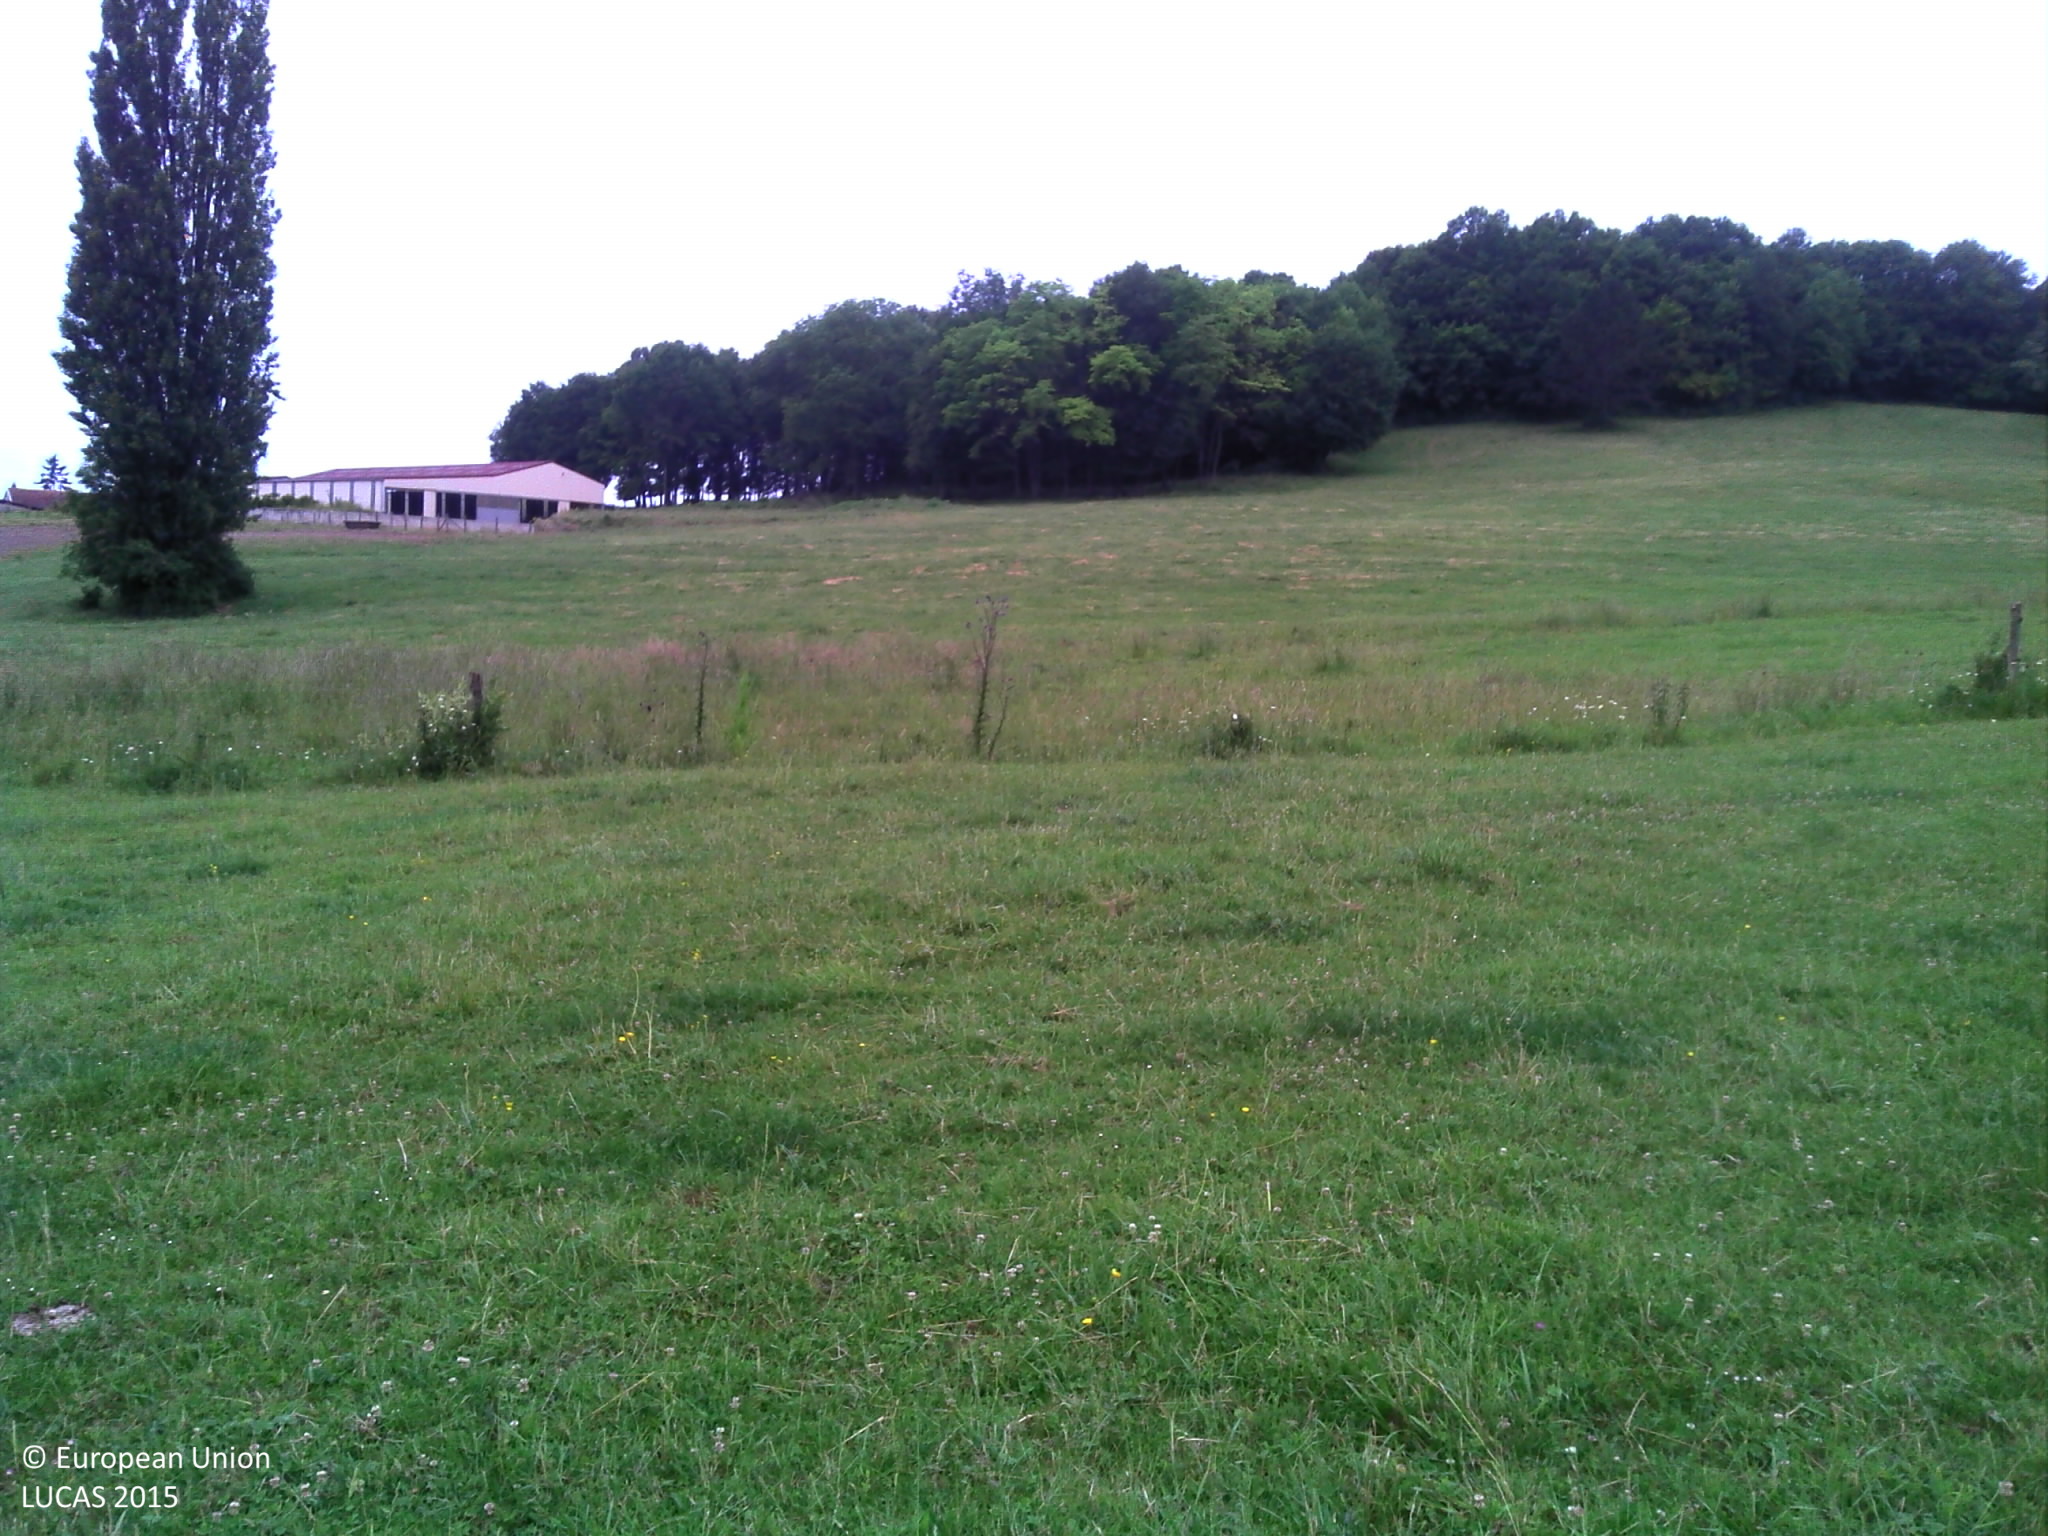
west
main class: Grassland
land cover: Grassland without tree/shrub cover
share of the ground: > 75 %
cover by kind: herbaceous plants 100 %
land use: Agriculture (excluding fallow land and kitchen gardens)
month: June
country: FR
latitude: 47.7303
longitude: 6.3345
